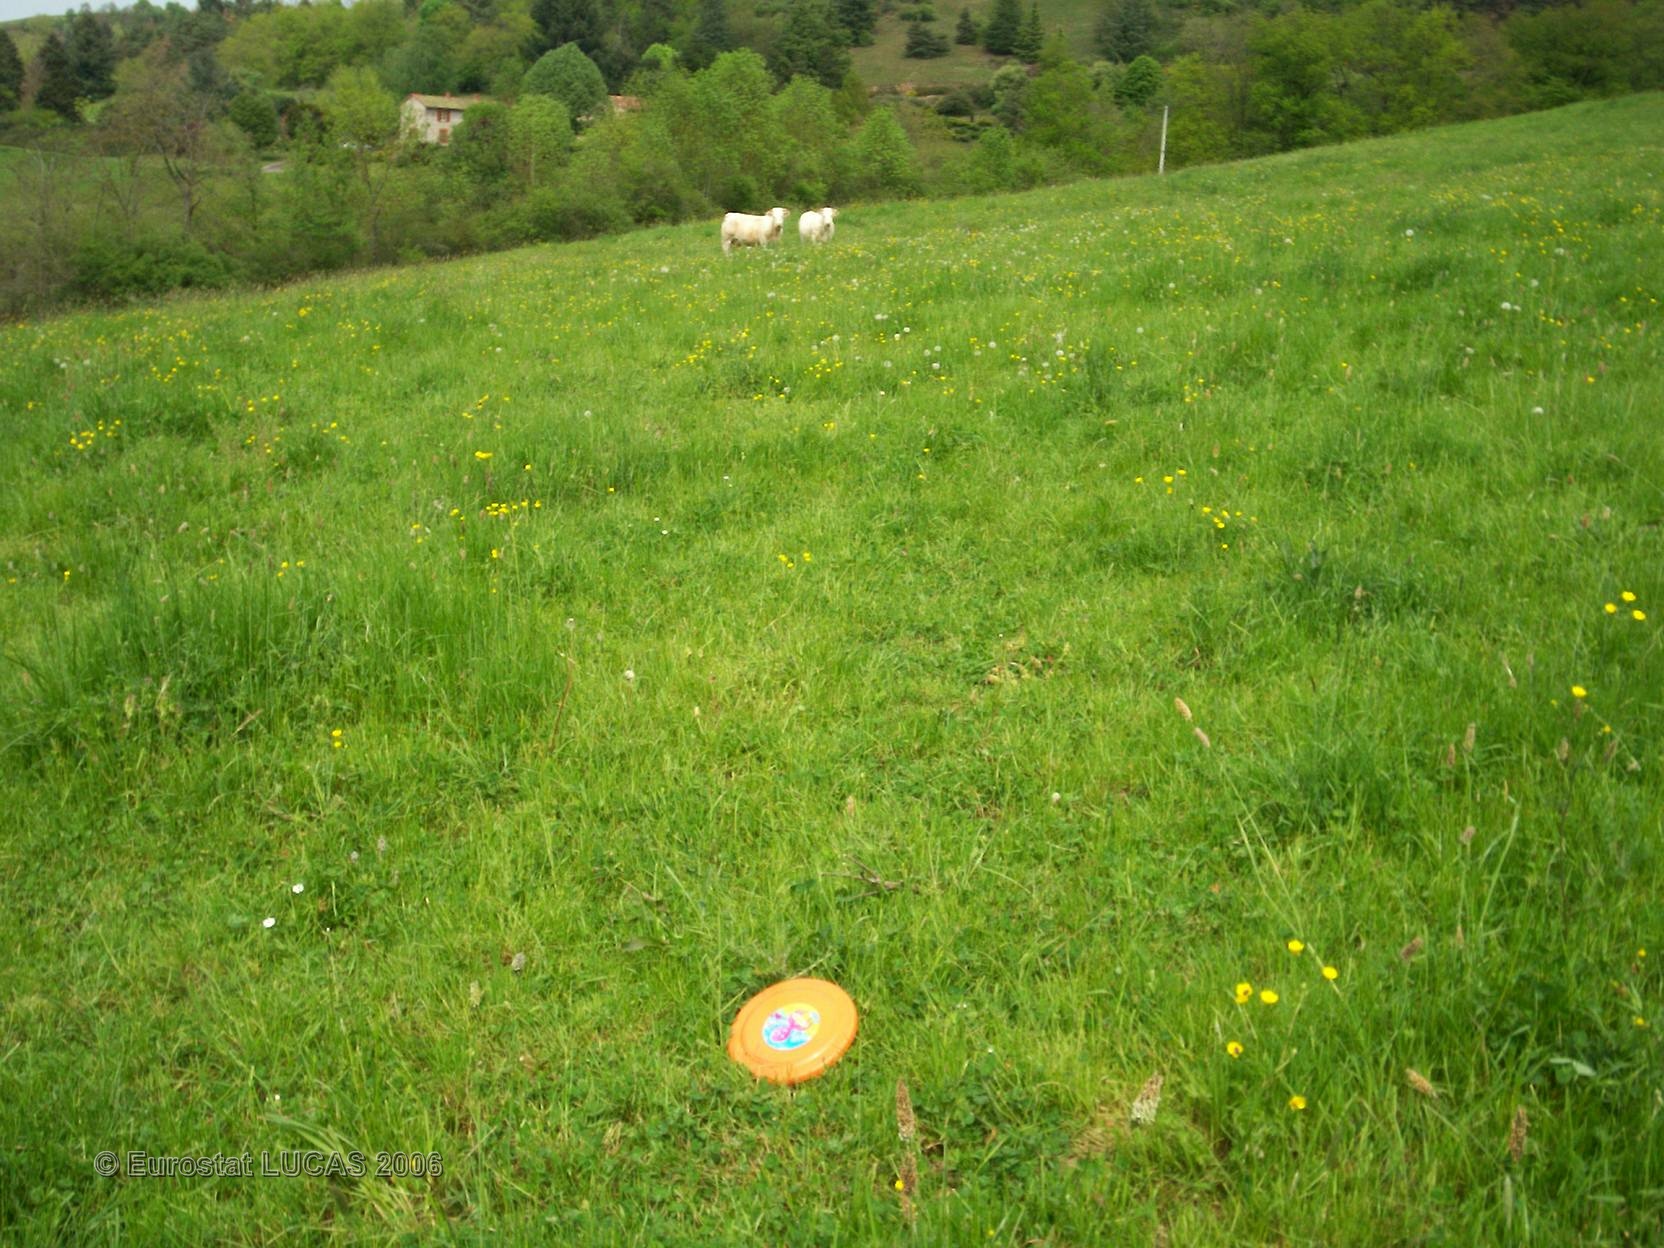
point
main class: Grassland
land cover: Grassland without tree/shrub cover
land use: Agriculture (excluding fallow land and kitchen gardens)
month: May
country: FR
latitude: 45.8821
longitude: 4.1136
